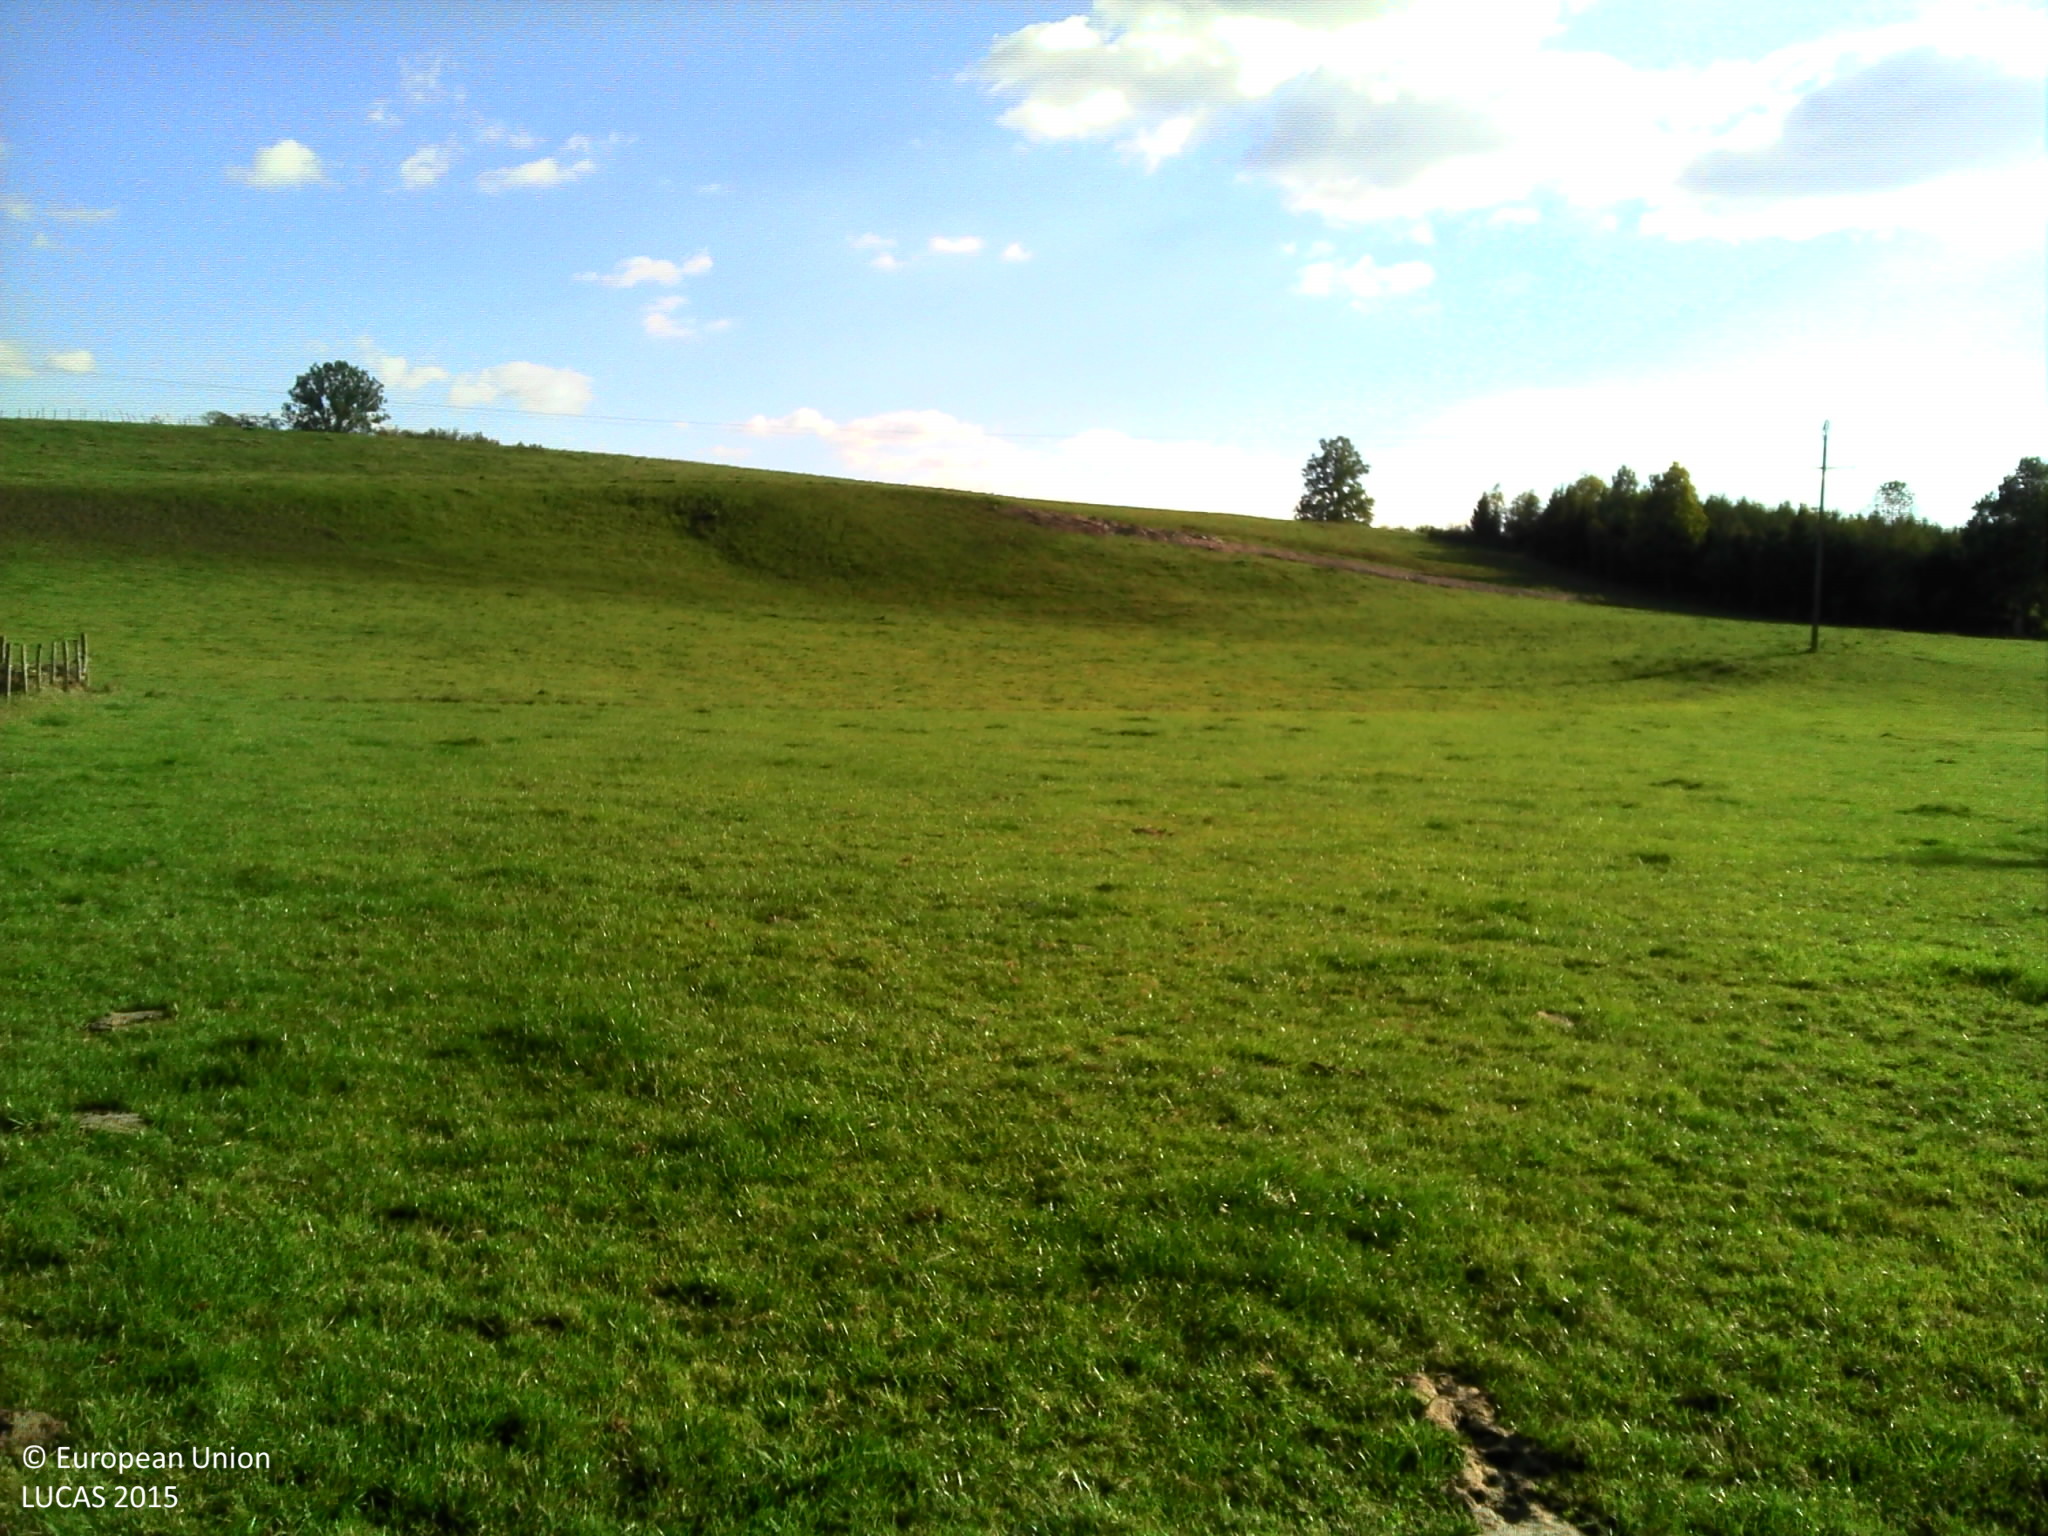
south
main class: Grassland
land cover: Grassland without tree/shrub cover
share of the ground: > 75 %
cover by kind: herbaceous plants 100 %
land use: Agriculture (excluding fallow land and kitchen gardens)
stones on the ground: < 10 %
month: September
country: FR
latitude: 47.2785
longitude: 6.8689
